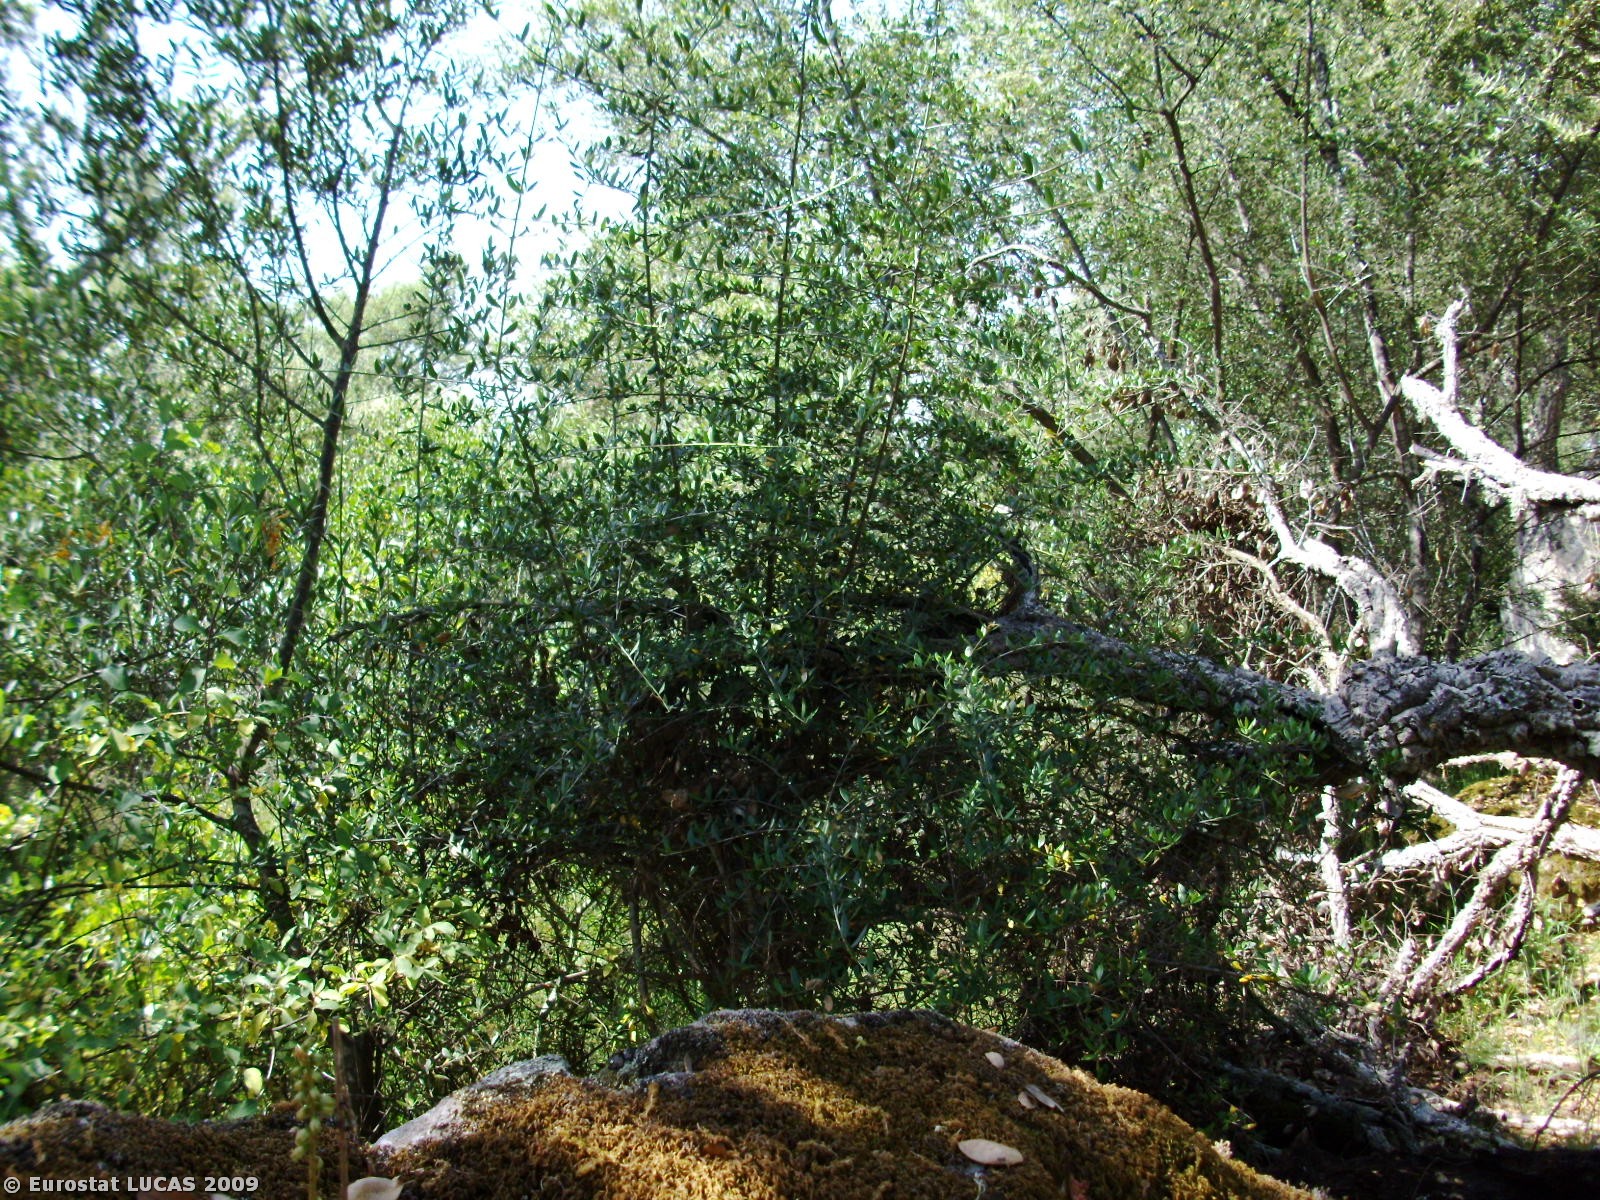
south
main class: Woodland
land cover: Broadleaved woodland
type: broadleaved evergreen forest
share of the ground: 50 - 75 %
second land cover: Shrubland with sparse tree cover
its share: 25 - 50 %
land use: Forestry
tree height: > 5 m
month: May
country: PT
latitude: 39.2778
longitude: -7.4650
